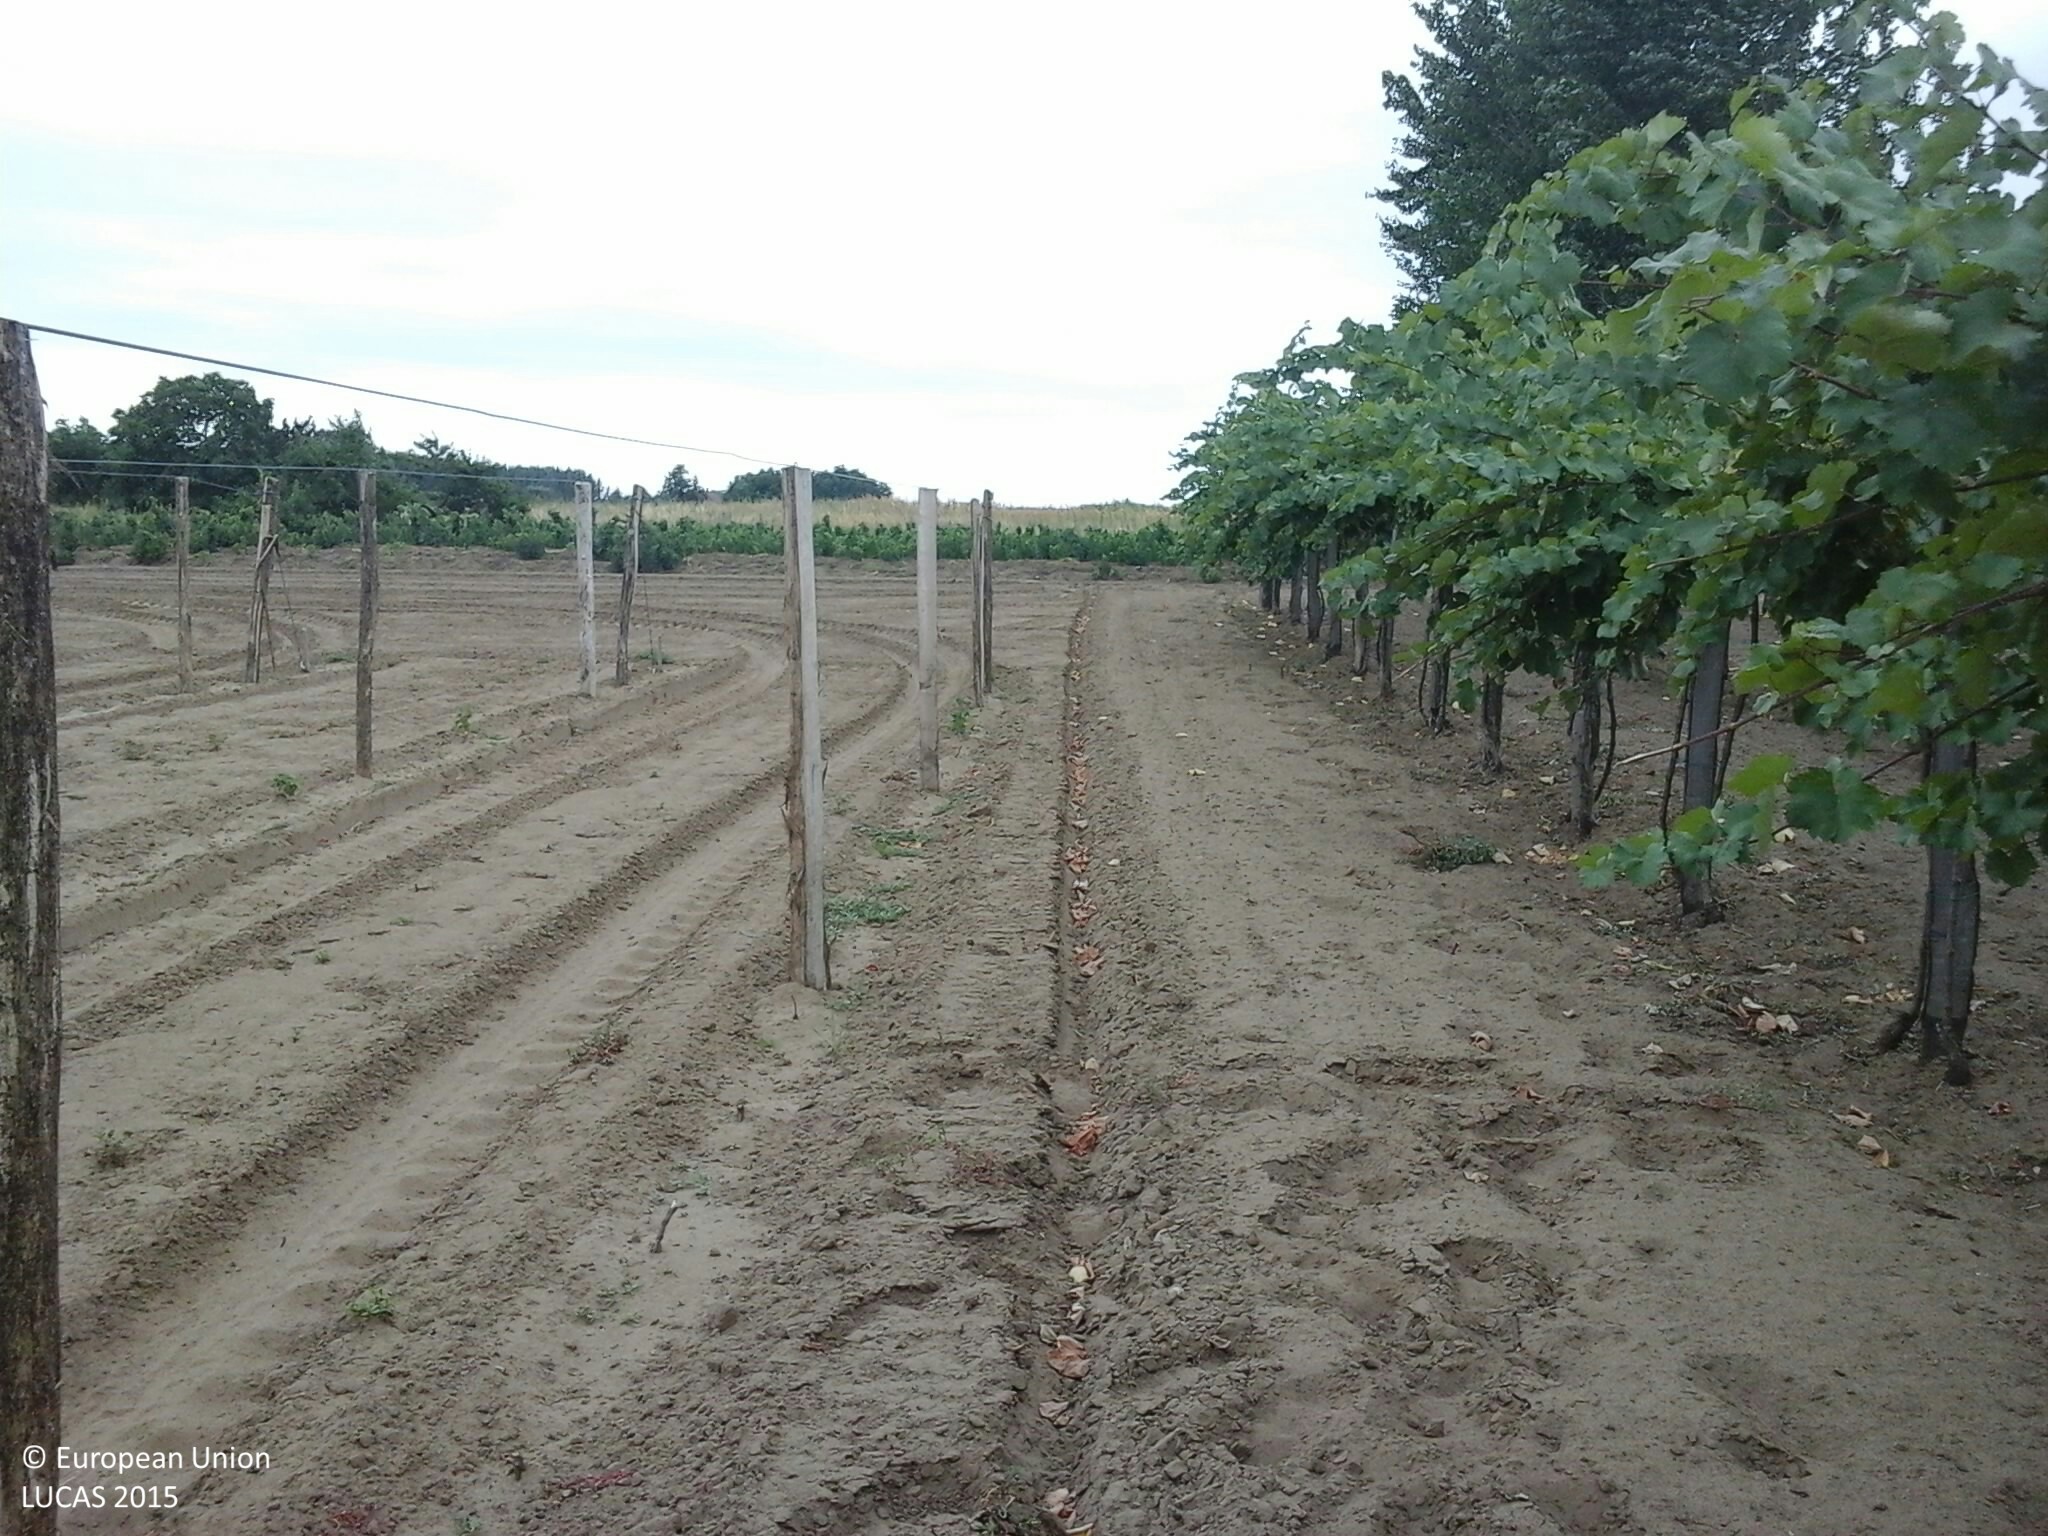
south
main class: Cropland
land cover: Vineyards
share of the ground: 25 - 50 %
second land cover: Other bare soil
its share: > 75 %
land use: Agriculture (excluding fallow land and kitchen gardens)
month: July
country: HU
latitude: 46.8484
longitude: 20.1355
